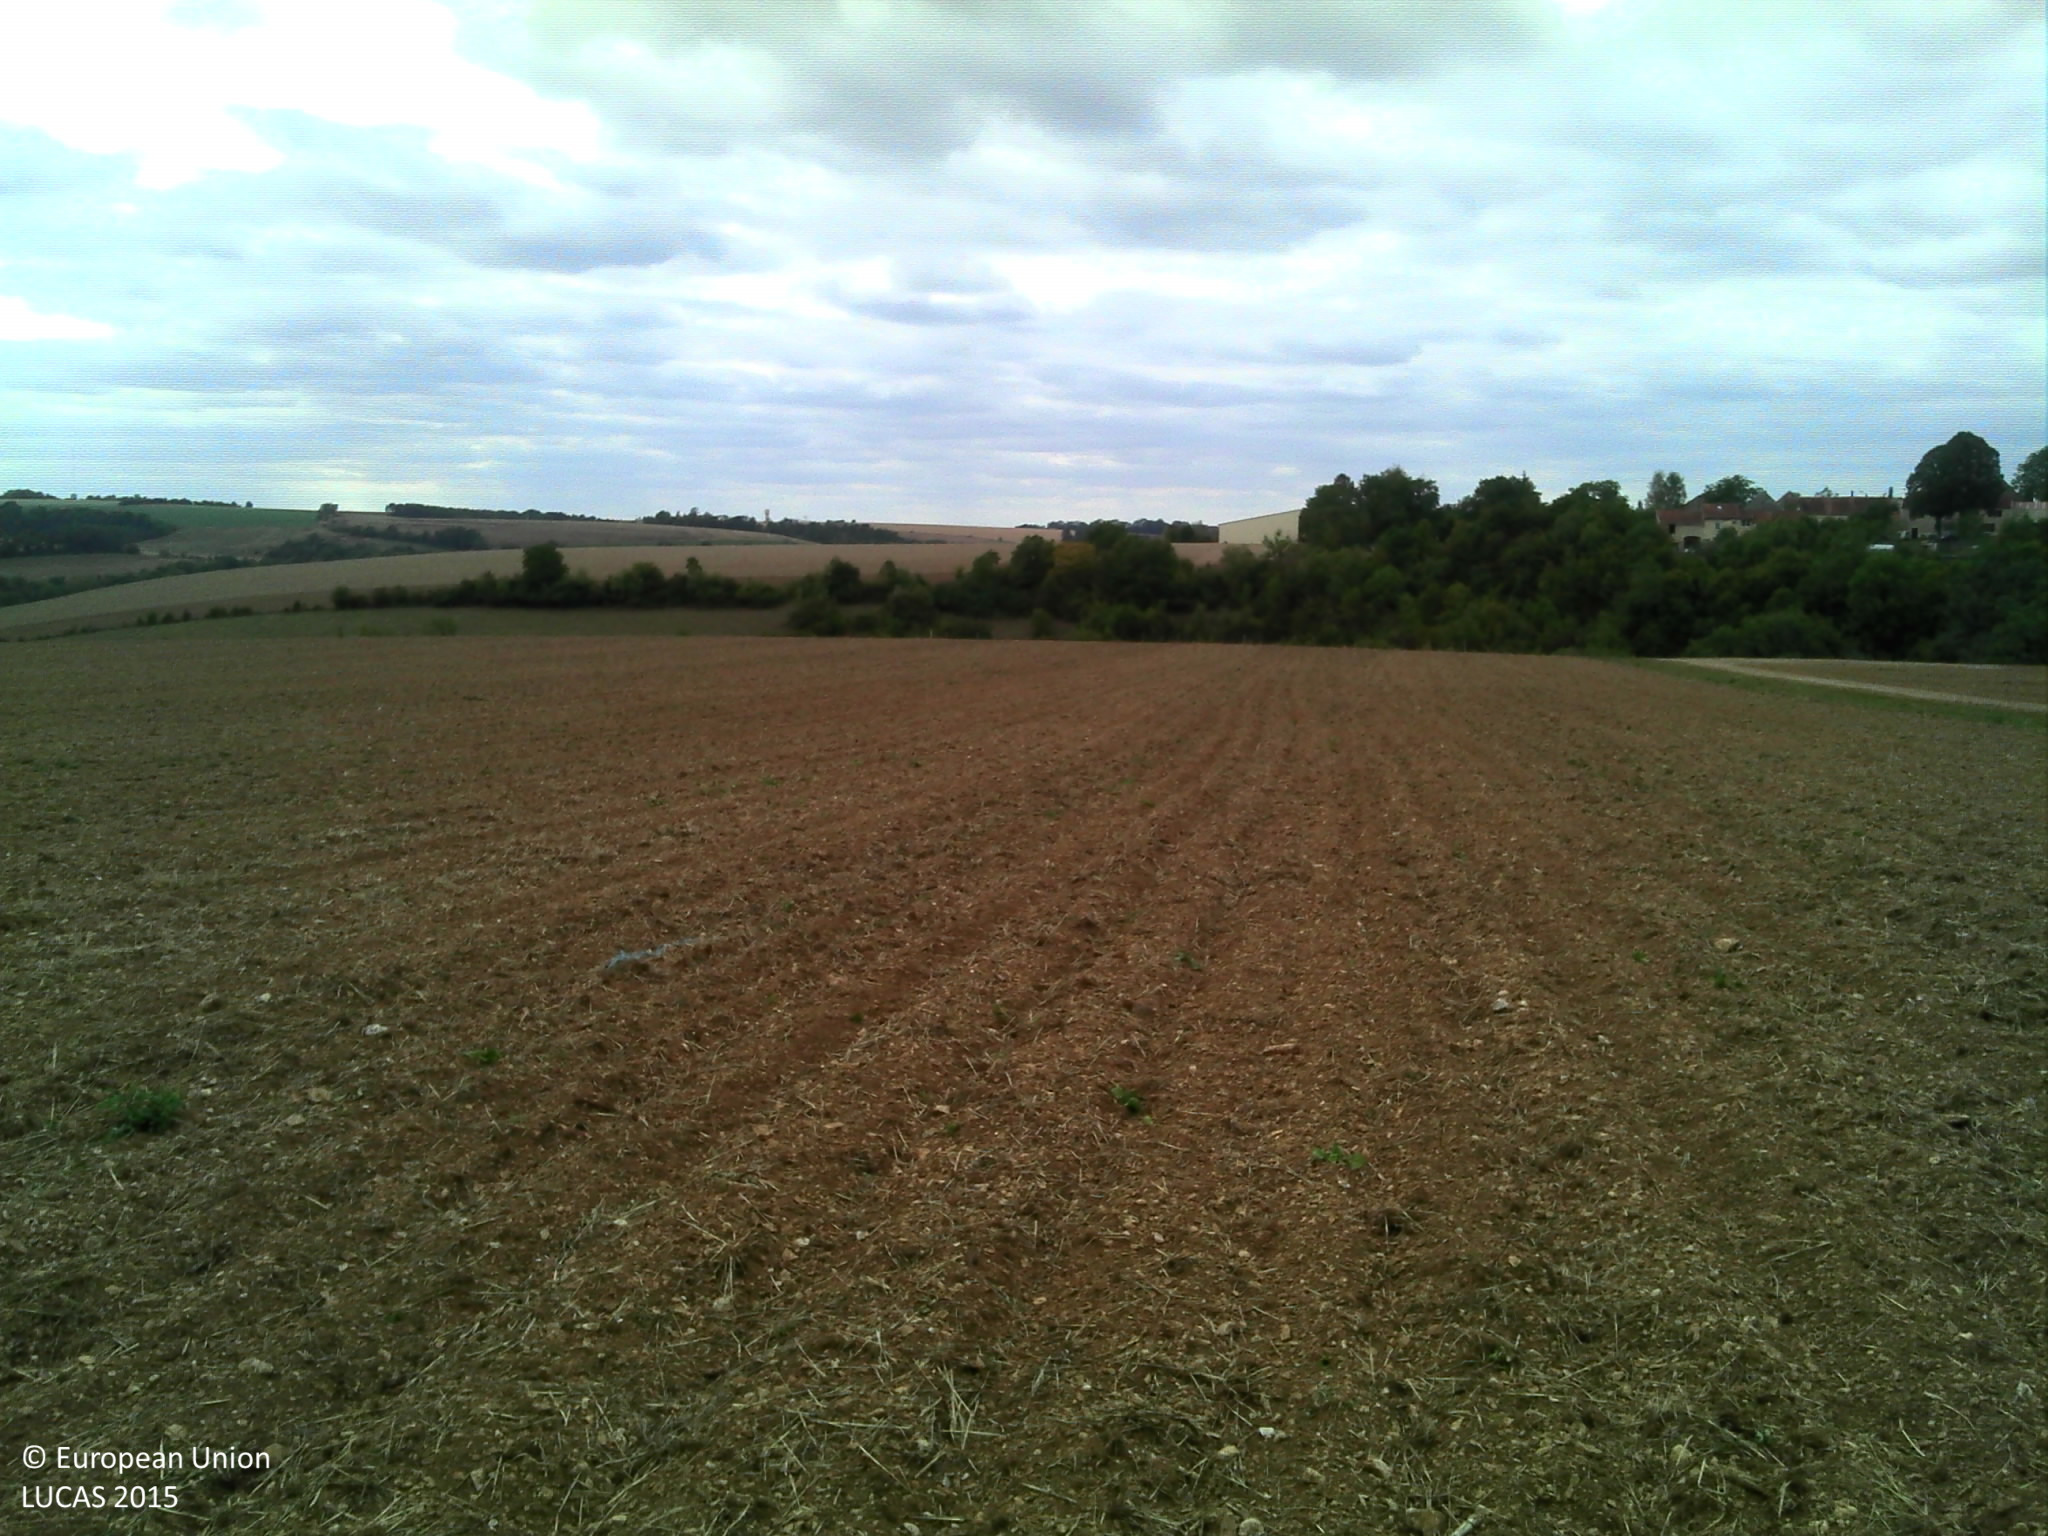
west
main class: Cropland
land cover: Common wheat
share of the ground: 10 - 25 %
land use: Agriculture (excluding fallow land and kitchen gardens)
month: September
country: FR
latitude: 47.5741
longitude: 4.7217
